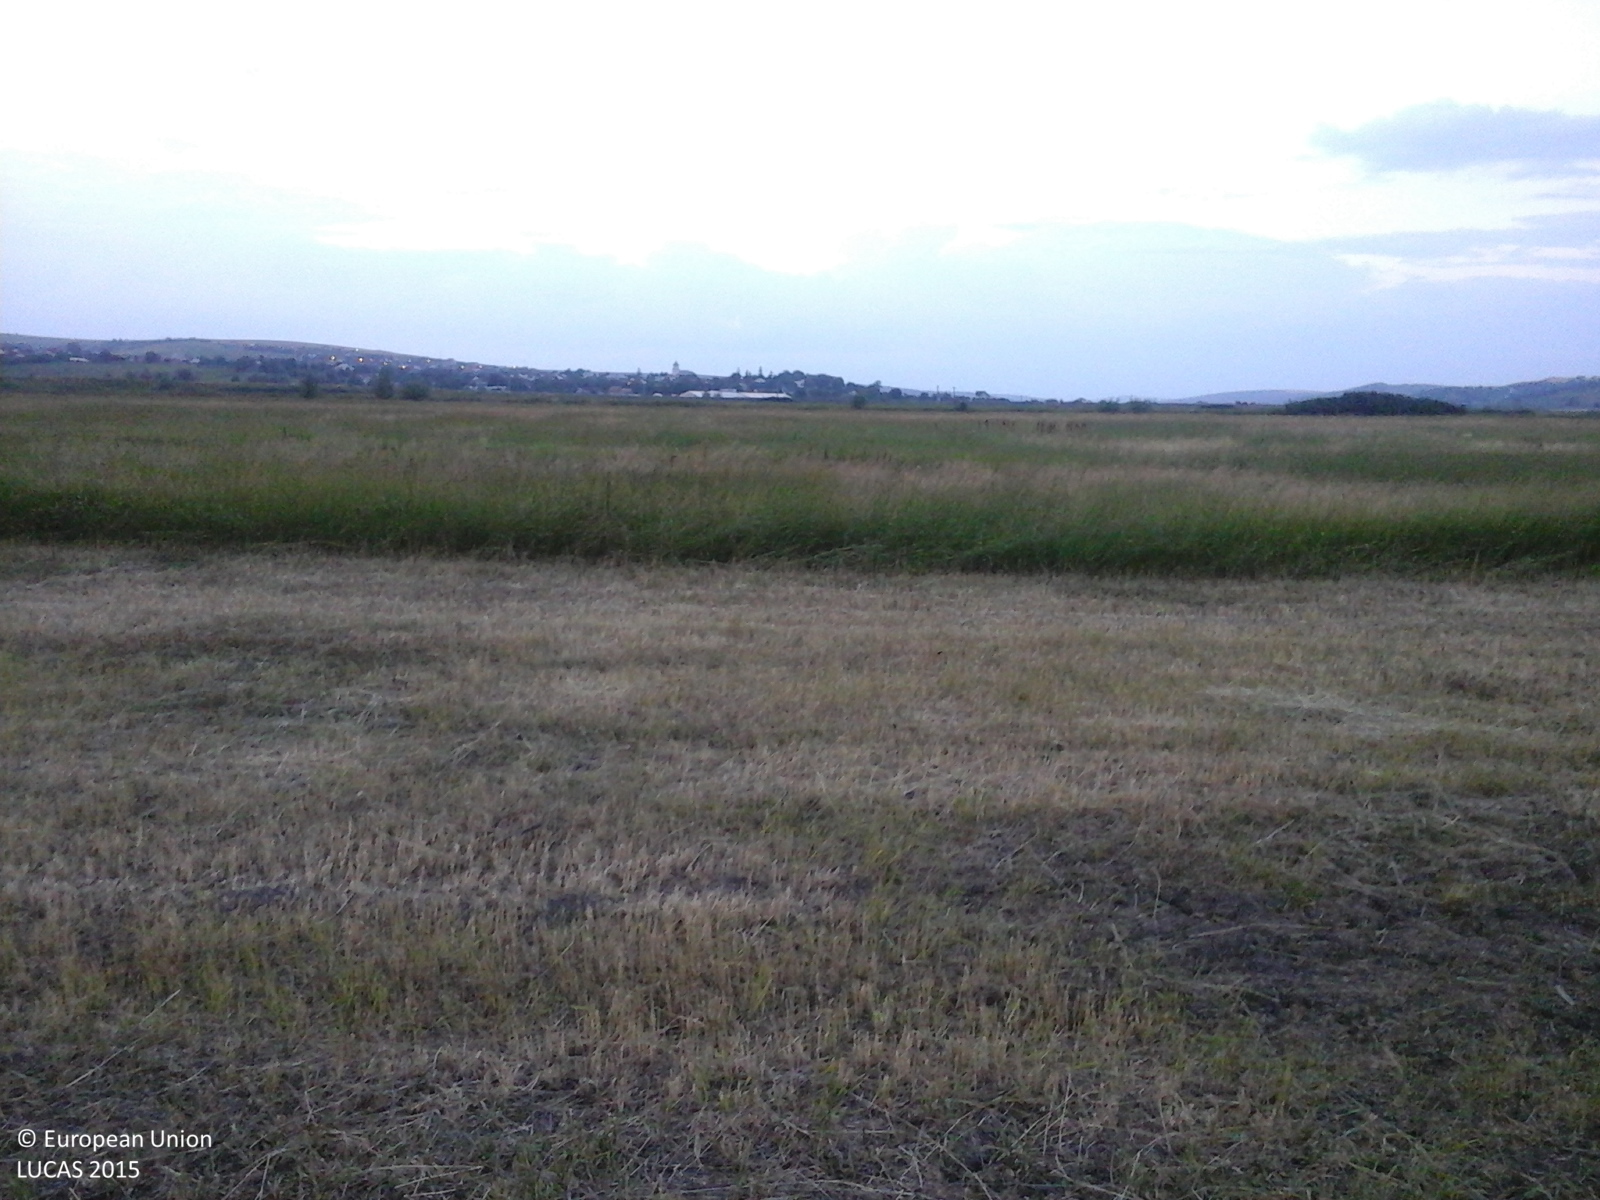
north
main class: Grassland
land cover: Grassland without tree/shrub cover
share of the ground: 10 - 25 %
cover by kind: herbaceous plants 100 %
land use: Agriculture (excluding fallow land and kitchen gardens)
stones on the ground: < 10 %
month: June
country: RO
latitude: 46.6571
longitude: 27.7483
